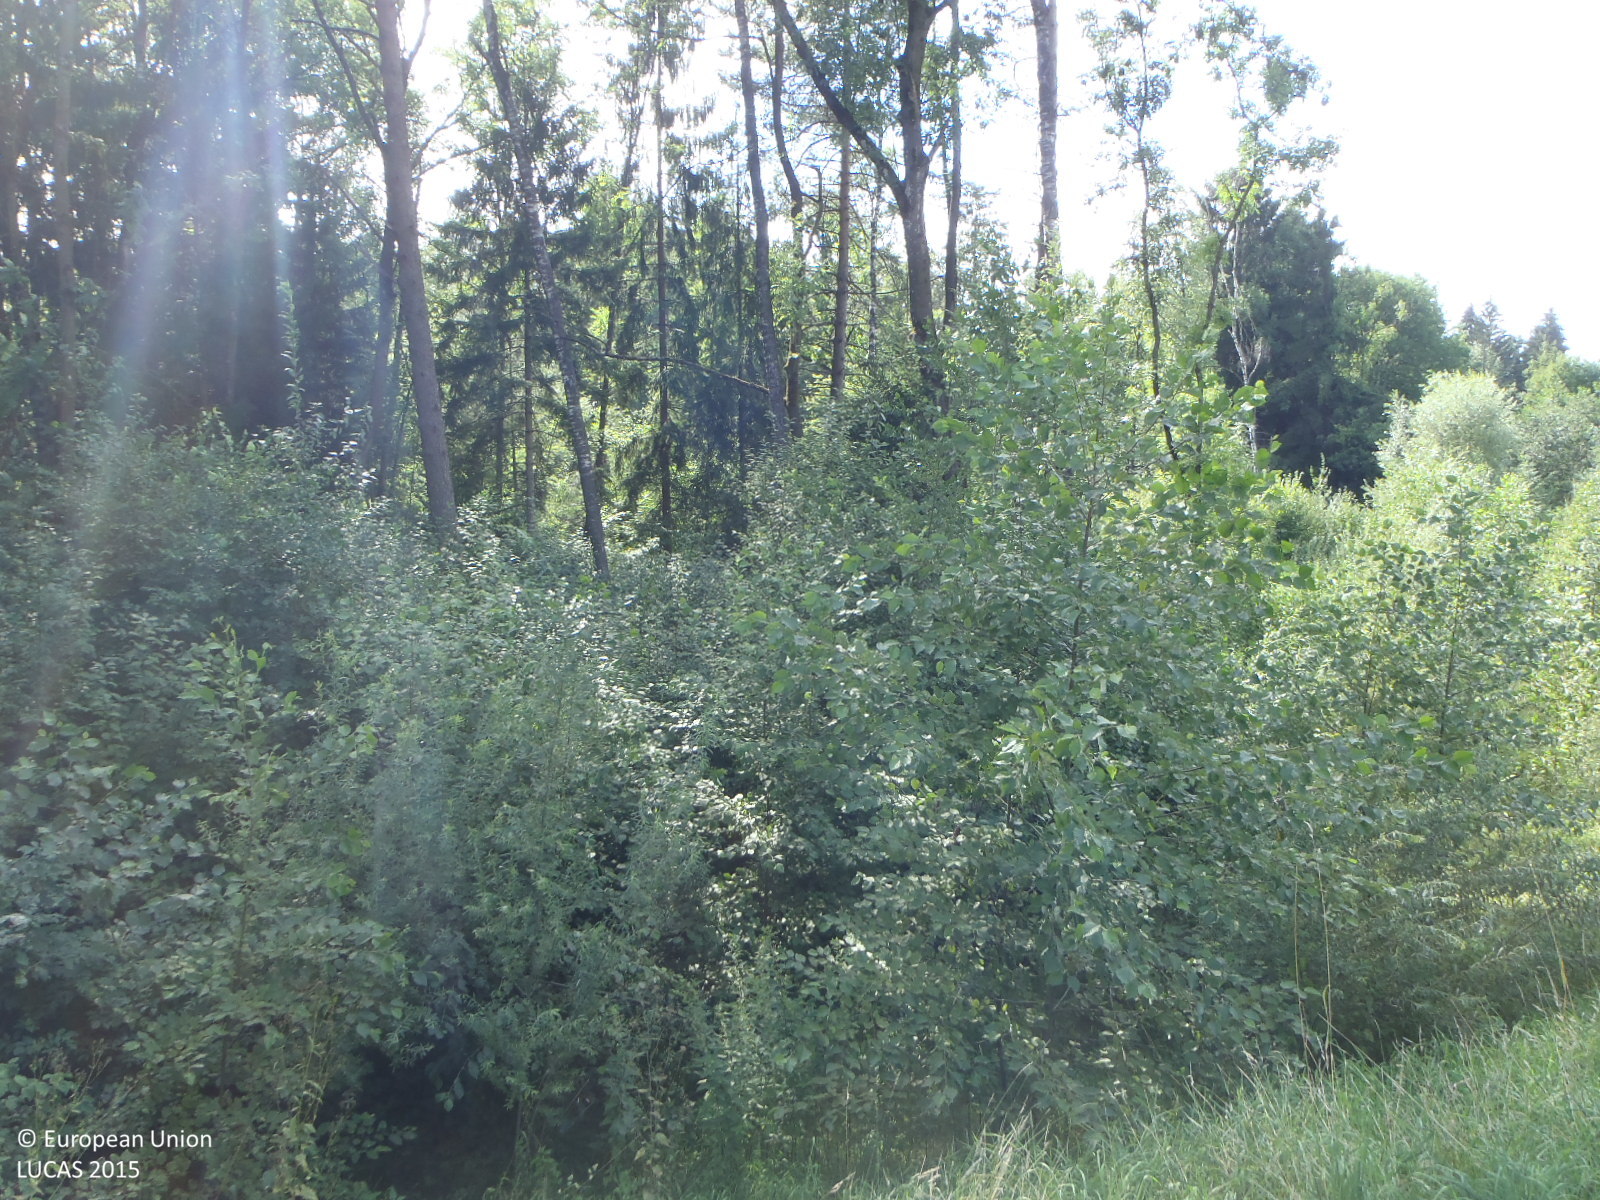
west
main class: Woodland
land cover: Other mixed woodland
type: alpine coniferous forest
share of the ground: > 75 %
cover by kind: coniferous forest trees 50 %, broadleaved forest trees 50 %
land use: Semi-natural and natural areas not in use
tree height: > 5 m
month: July
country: CH
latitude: 47.3771
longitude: 9.6692
